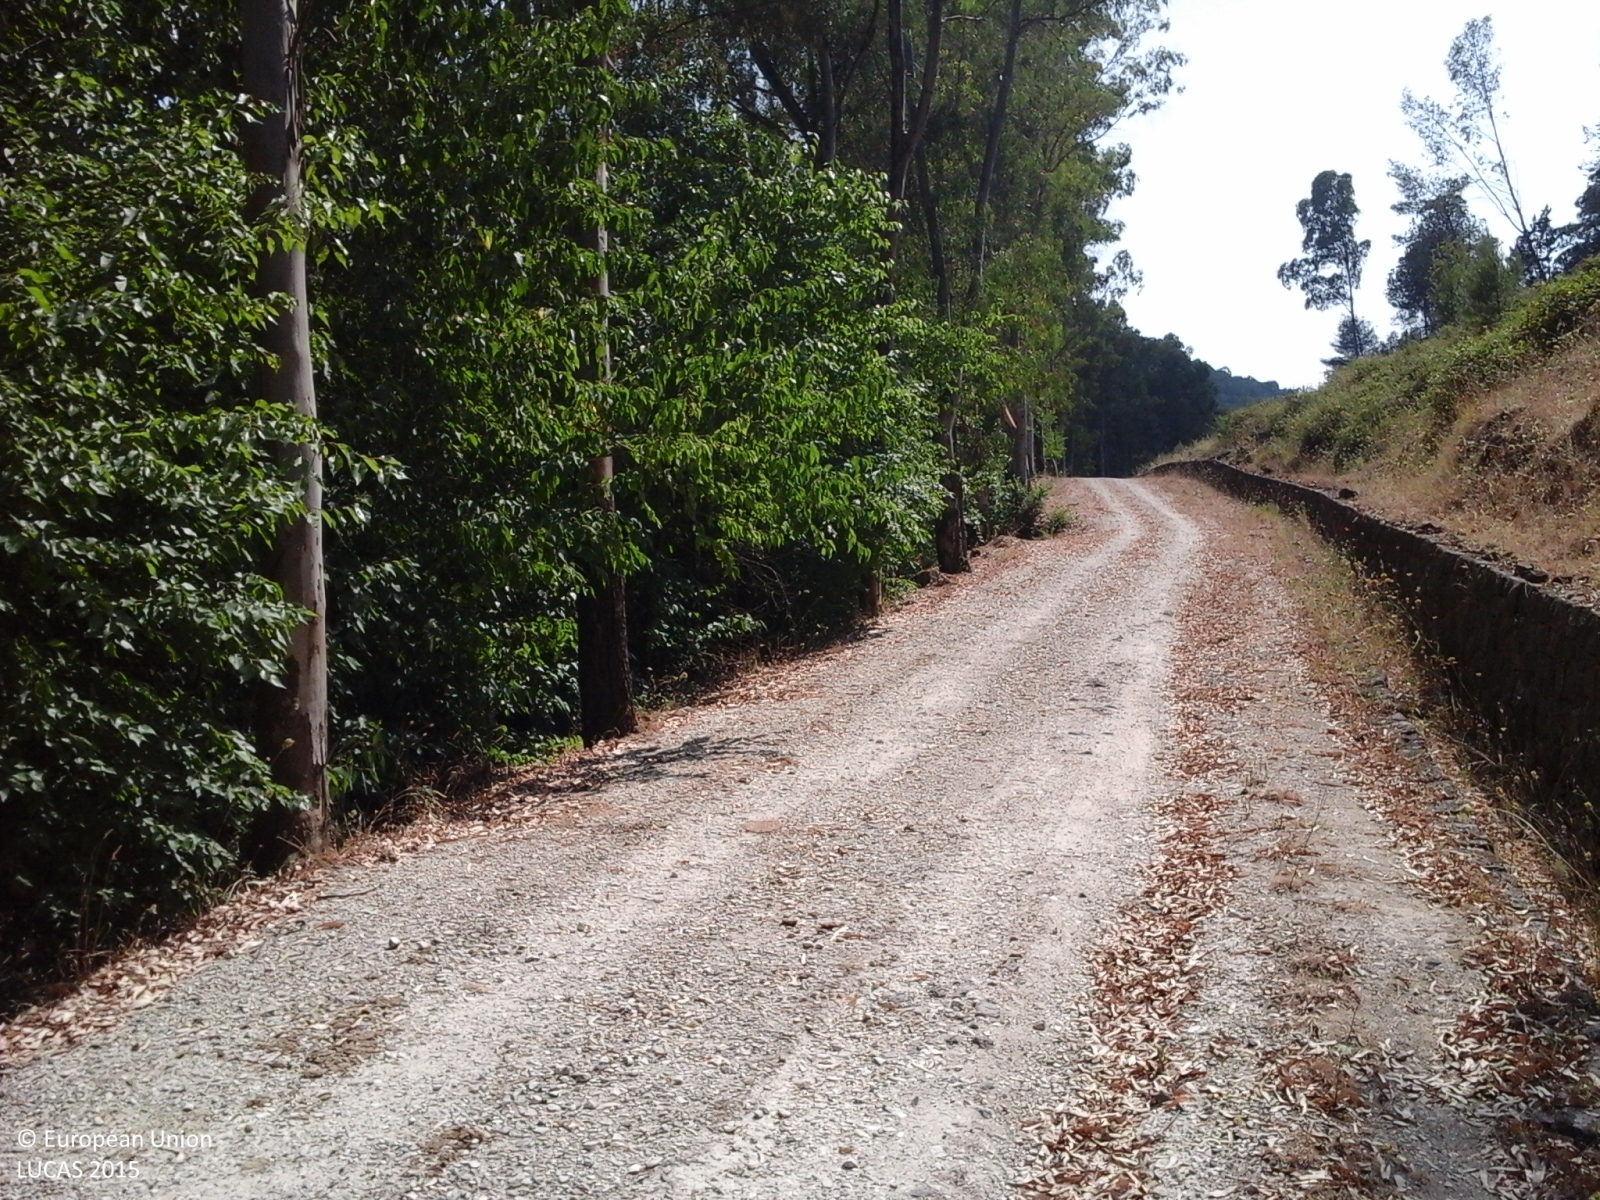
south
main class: Woodland
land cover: Other mixed woodland
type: broadleaved evergreen forest
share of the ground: > 75 %
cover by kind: herbaceous plants 50 %, coniferous forest trees 20 %, broadleaved forest trees 20 %, shrubs 10 %
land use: Forestry
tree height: > 5 m
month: July
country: IT
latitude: 37.2082
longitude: 14.7975
